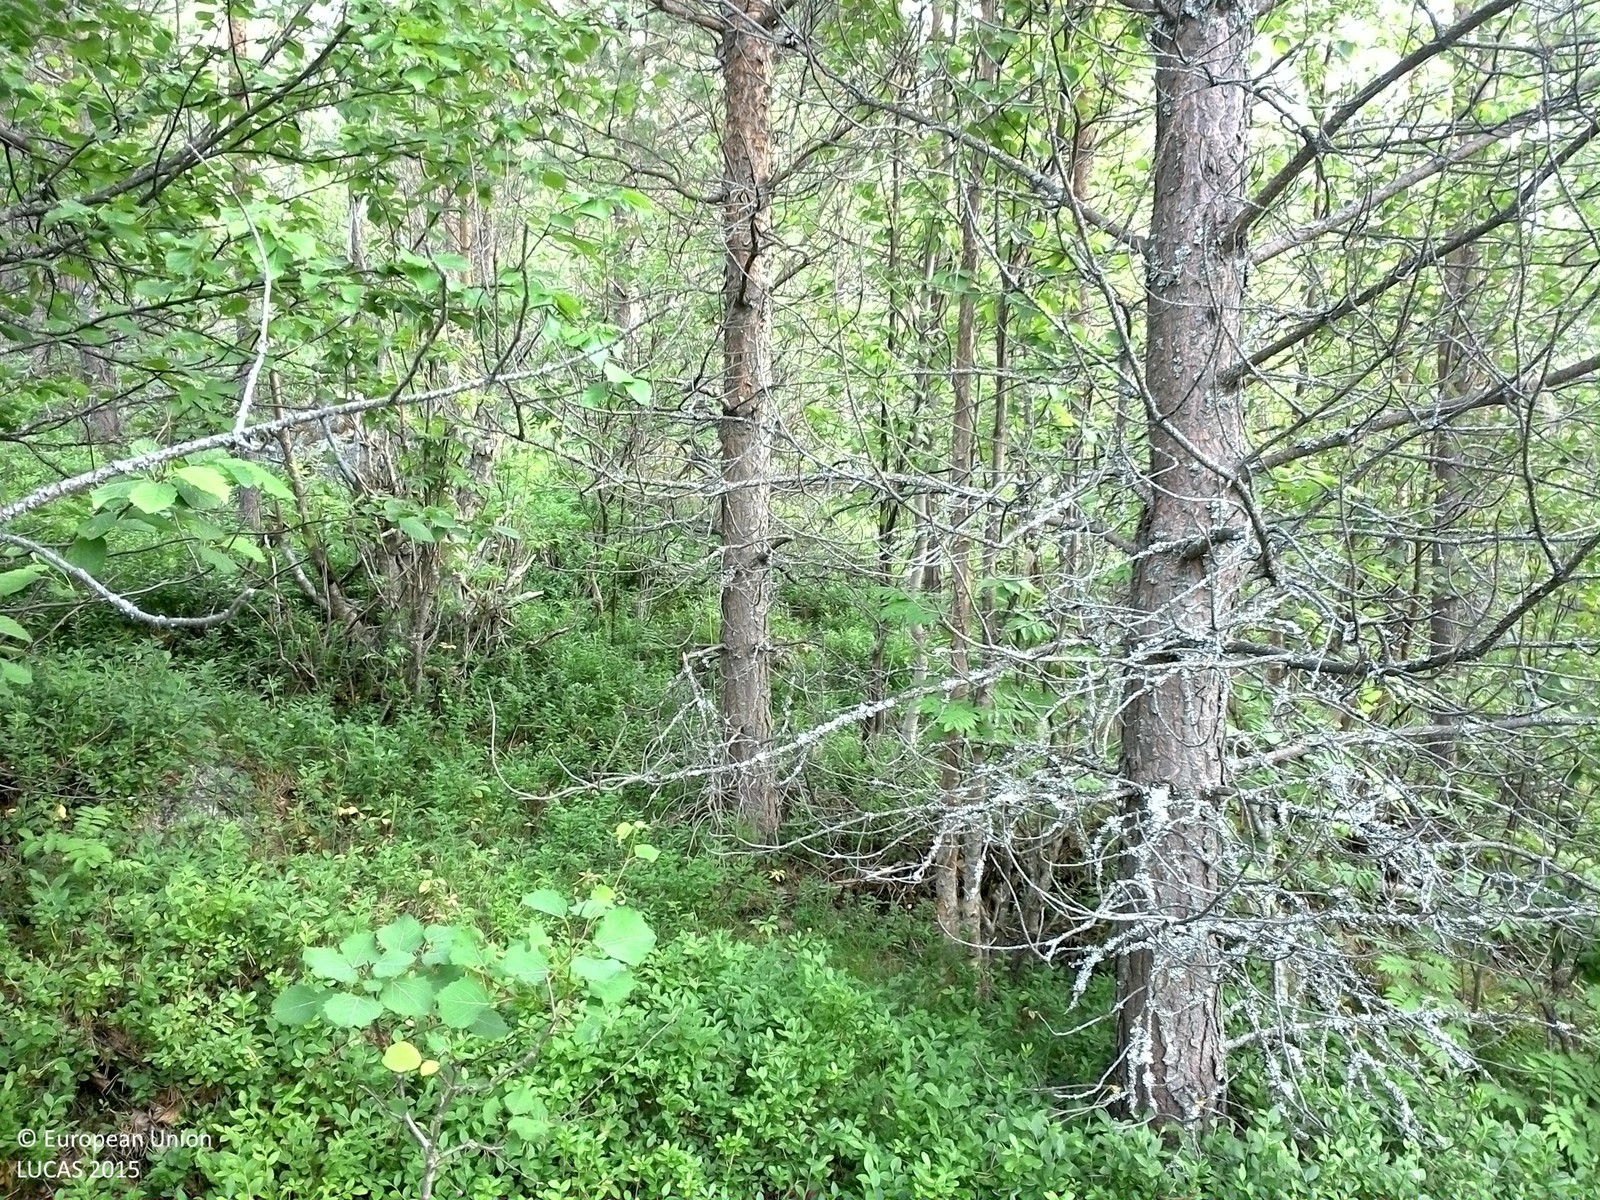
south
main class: Woodland
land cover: Pine dominated mixed woodland
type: boreal forest
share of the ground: 50 - 75 %
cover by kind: coniferous forest trees 45 %, shrubs 25 %, broadleaved forest trees 15 %, lichens and mosses 10 %, herbaceous plants 5 %
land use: Forestry
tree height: > 5 m
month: August
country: SE
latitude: 63.7405
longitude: 16.4753
